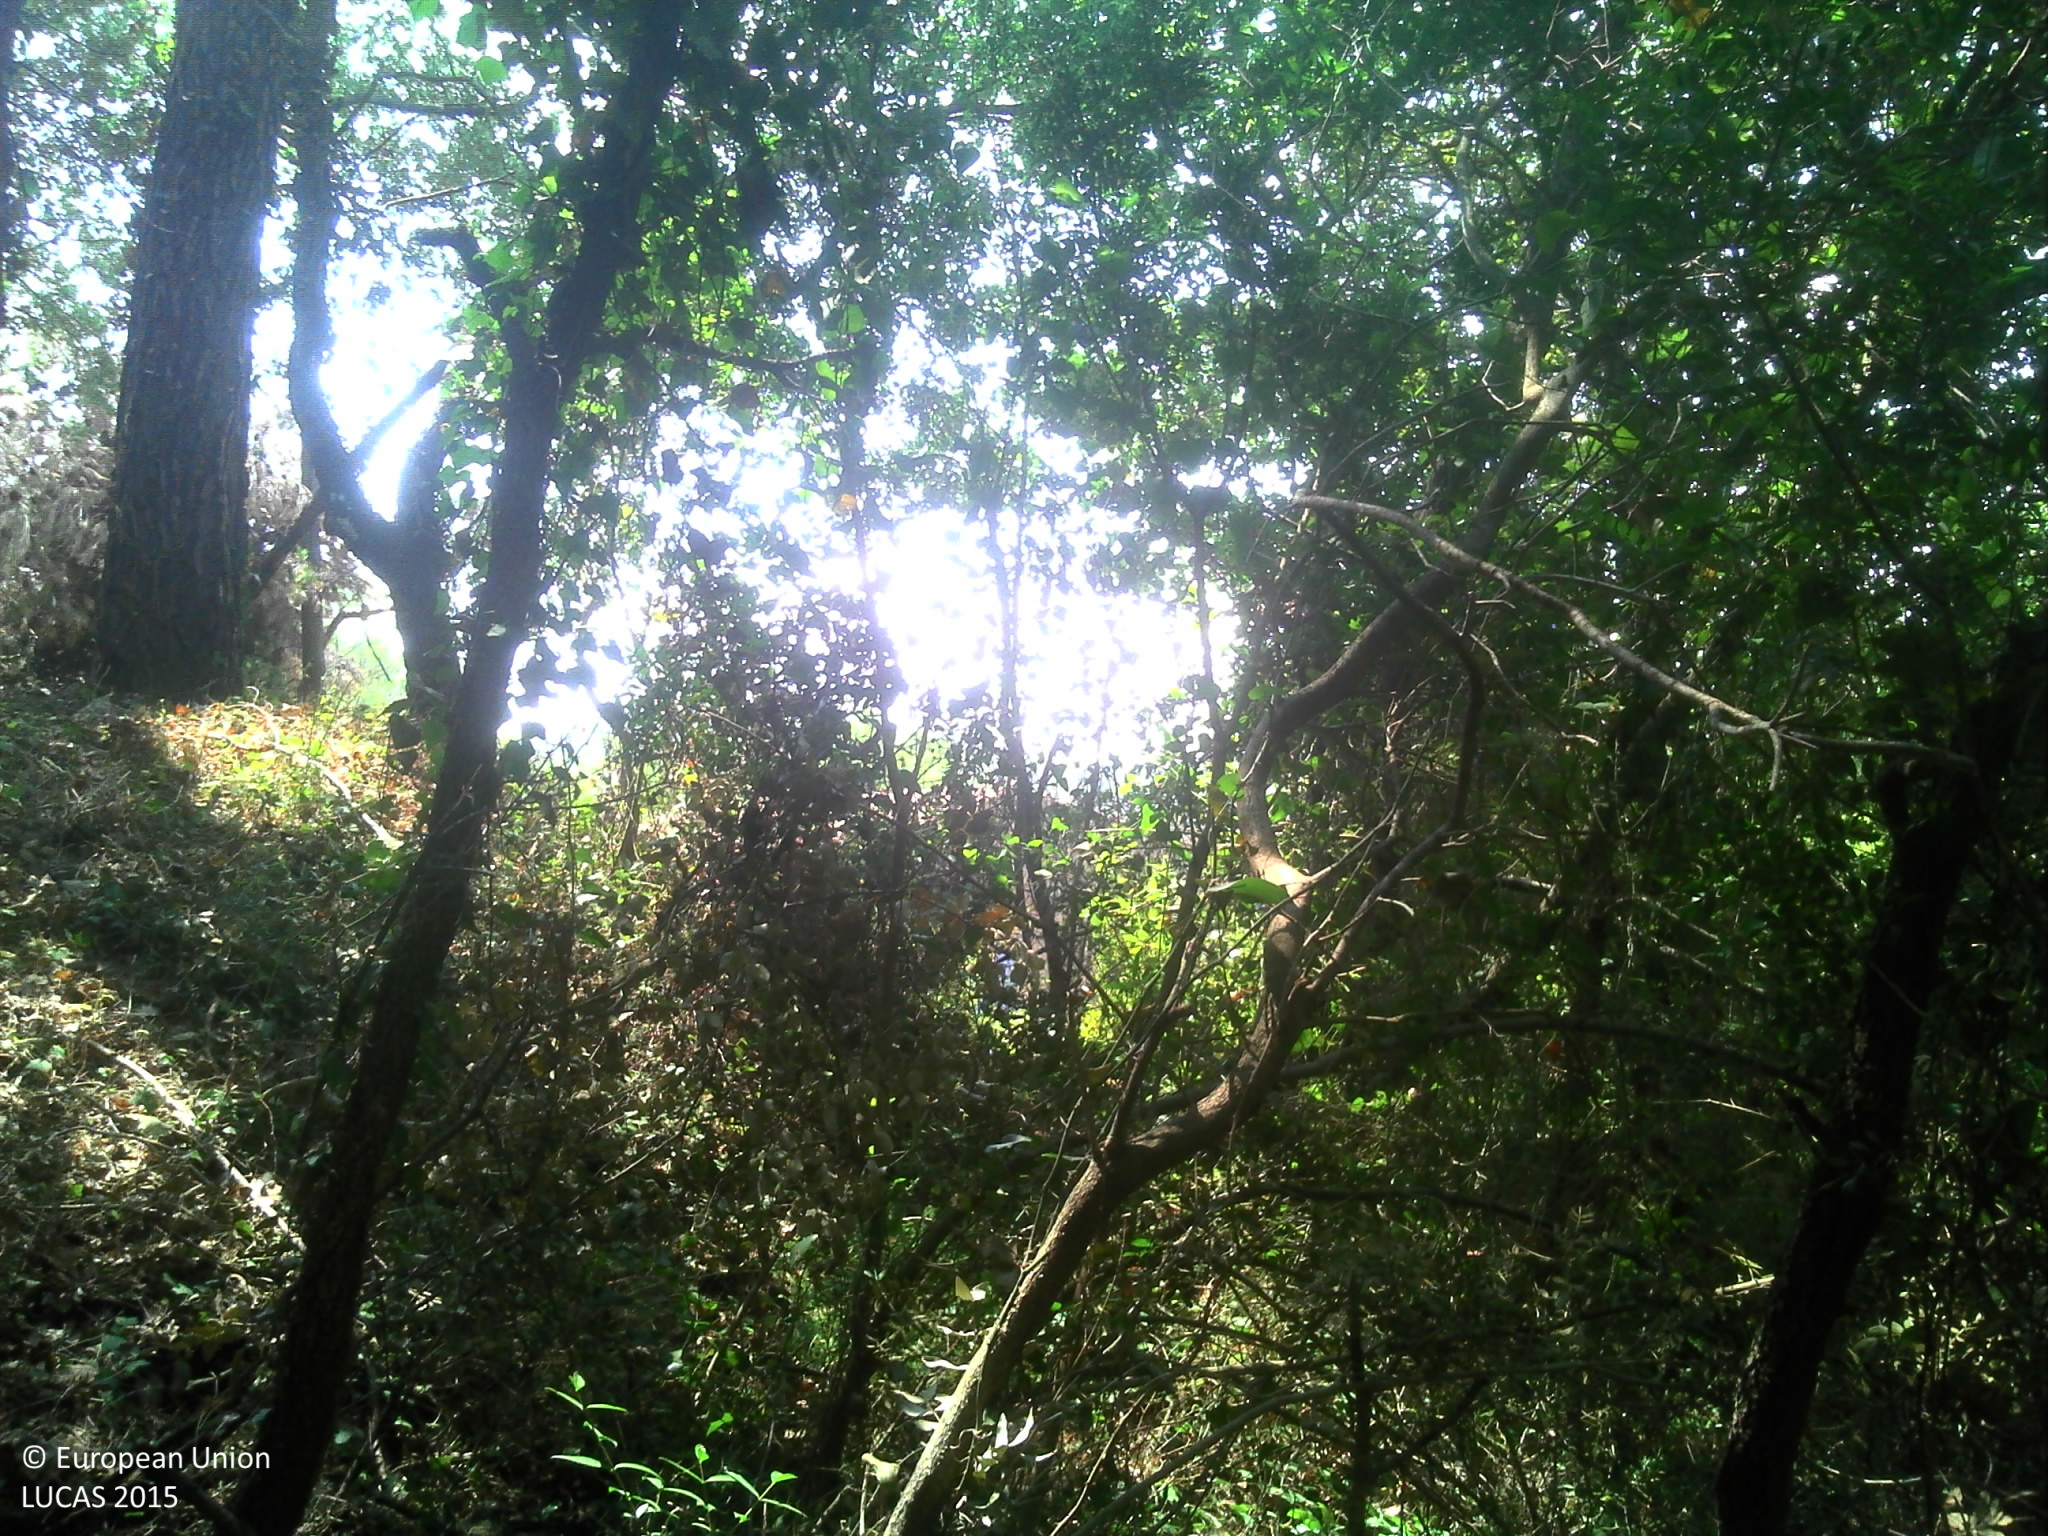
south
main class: Woodland
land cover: Pine dominated mixed woodland
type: broadleaved evergreen forest
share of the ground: > 75 %
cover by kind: coniferous forest trees 50 %, broadleaved forest trees 30 %, unconsolidated bare surface 10 %
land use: Semi-natural and natural areas not in use
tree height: > 5 m
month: July
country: FR
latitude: 43.3994
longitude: 6.2926
